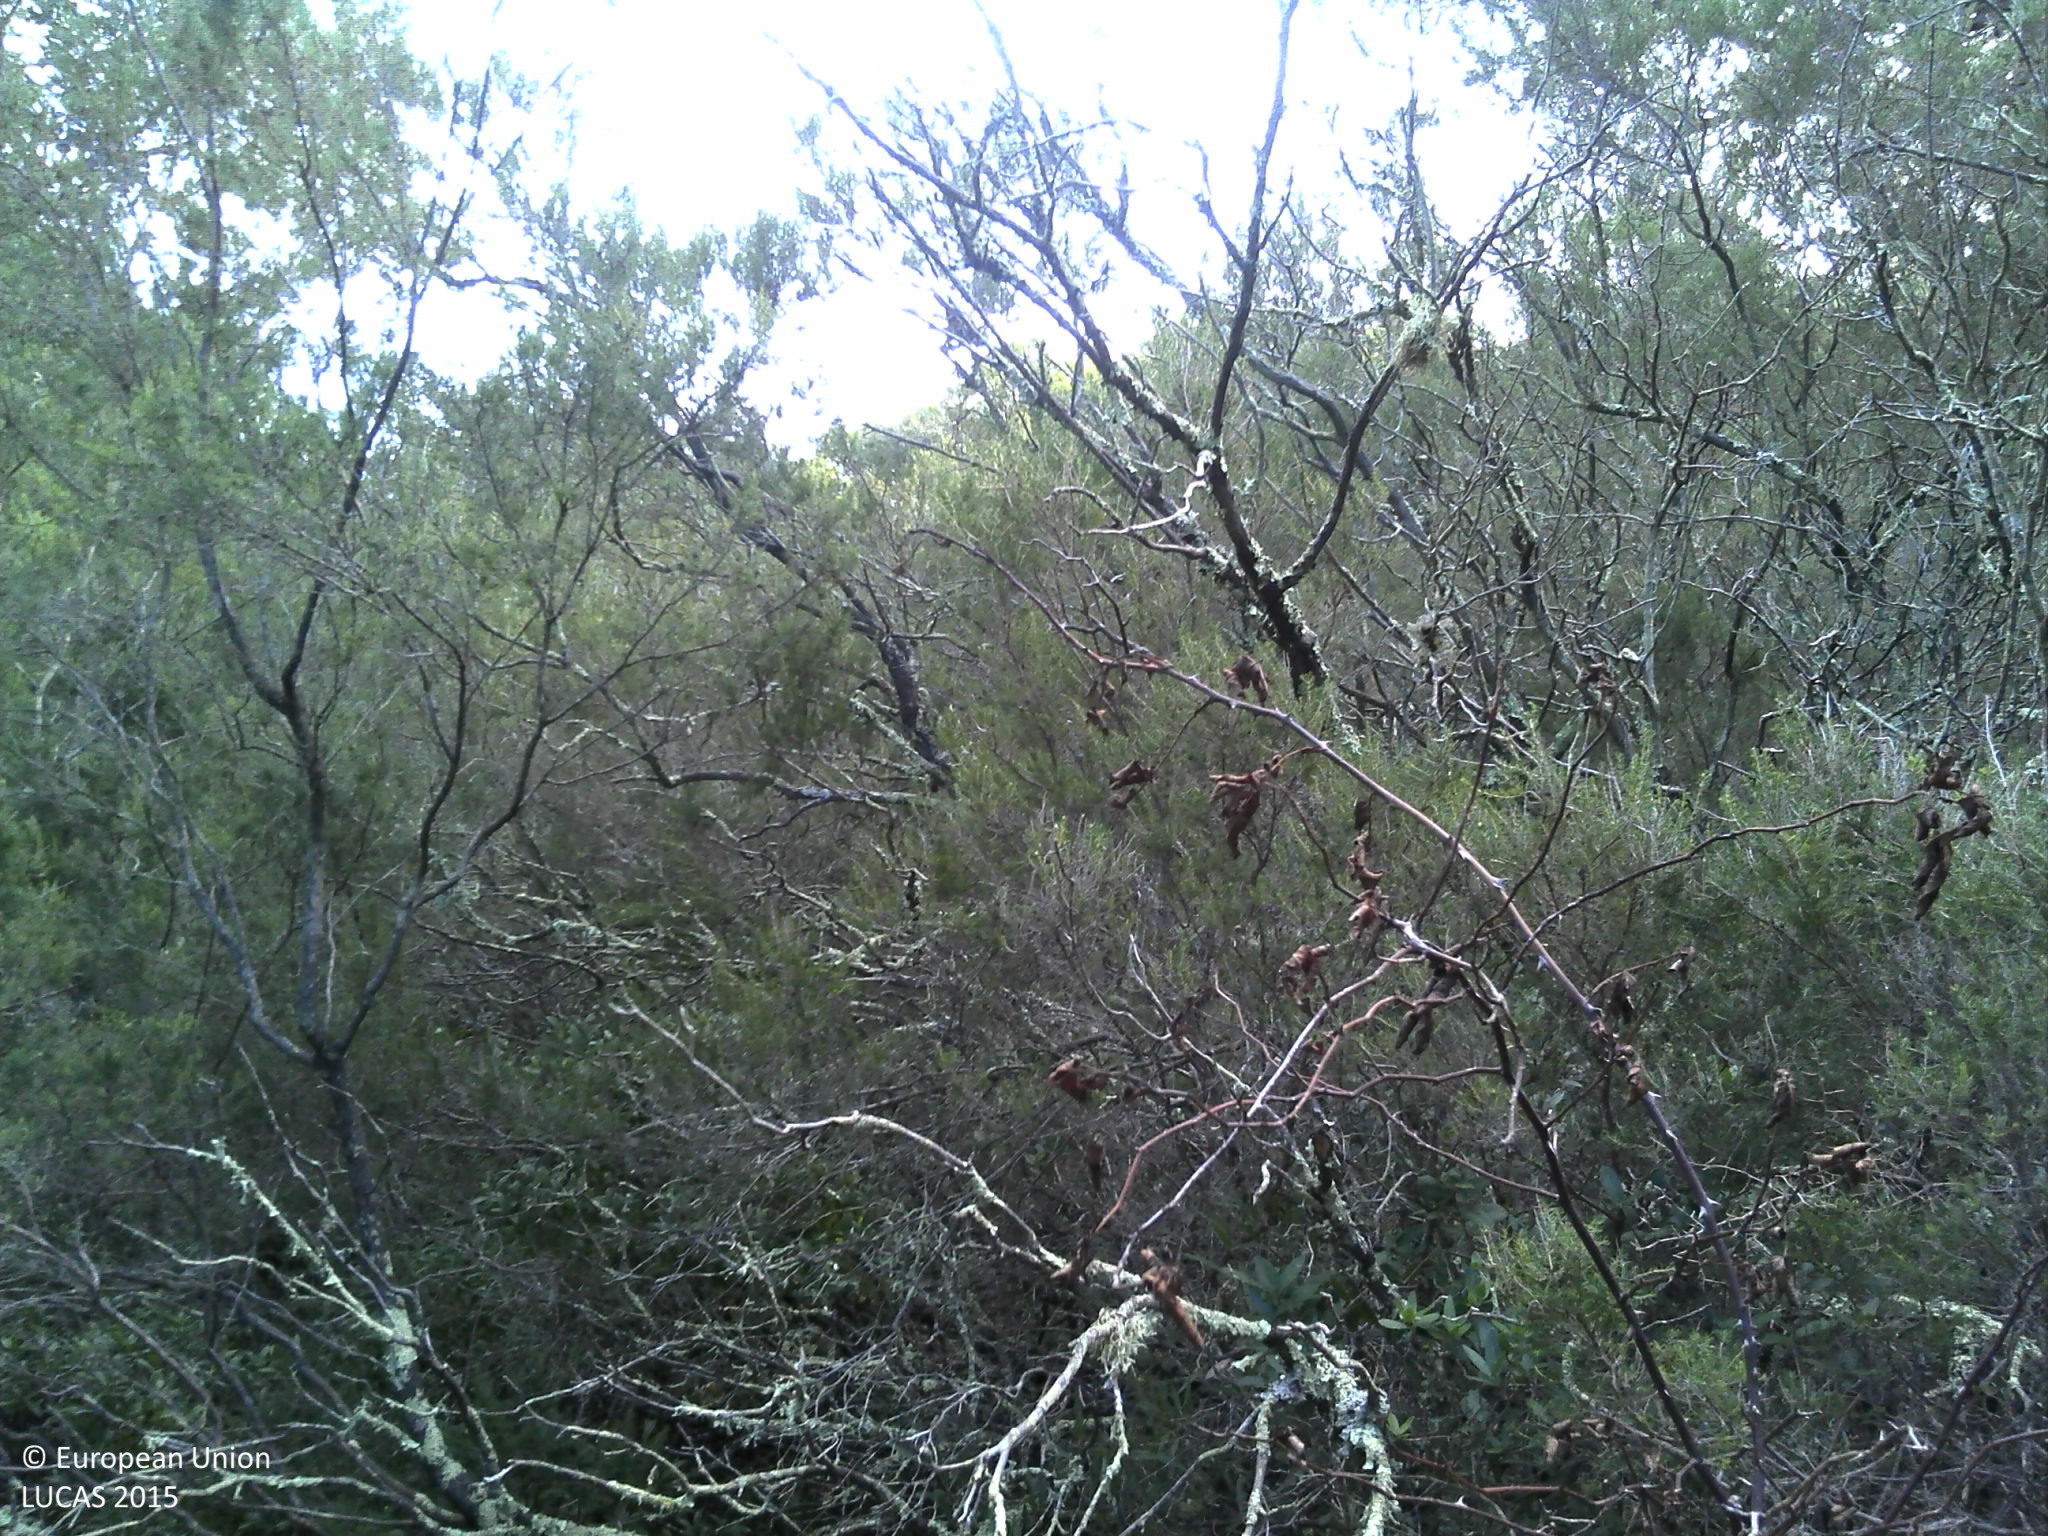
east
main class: Woodland
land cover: Pine dominated mixed woodland
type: broadleaved evergreen forest
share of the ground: > 75 %
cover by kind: broadleaved forest trees 50 %, coniferous forest trees 25 %, shrubs 25 %
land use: Semi-natural and natural areas not in use
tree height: > 5 m
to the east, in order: Pine dominated mixed woodland; Shrubland with sparse tree cover; Pine dominated mixed woodland
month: October
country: FR
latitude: 43.1941
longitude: 6.6249
